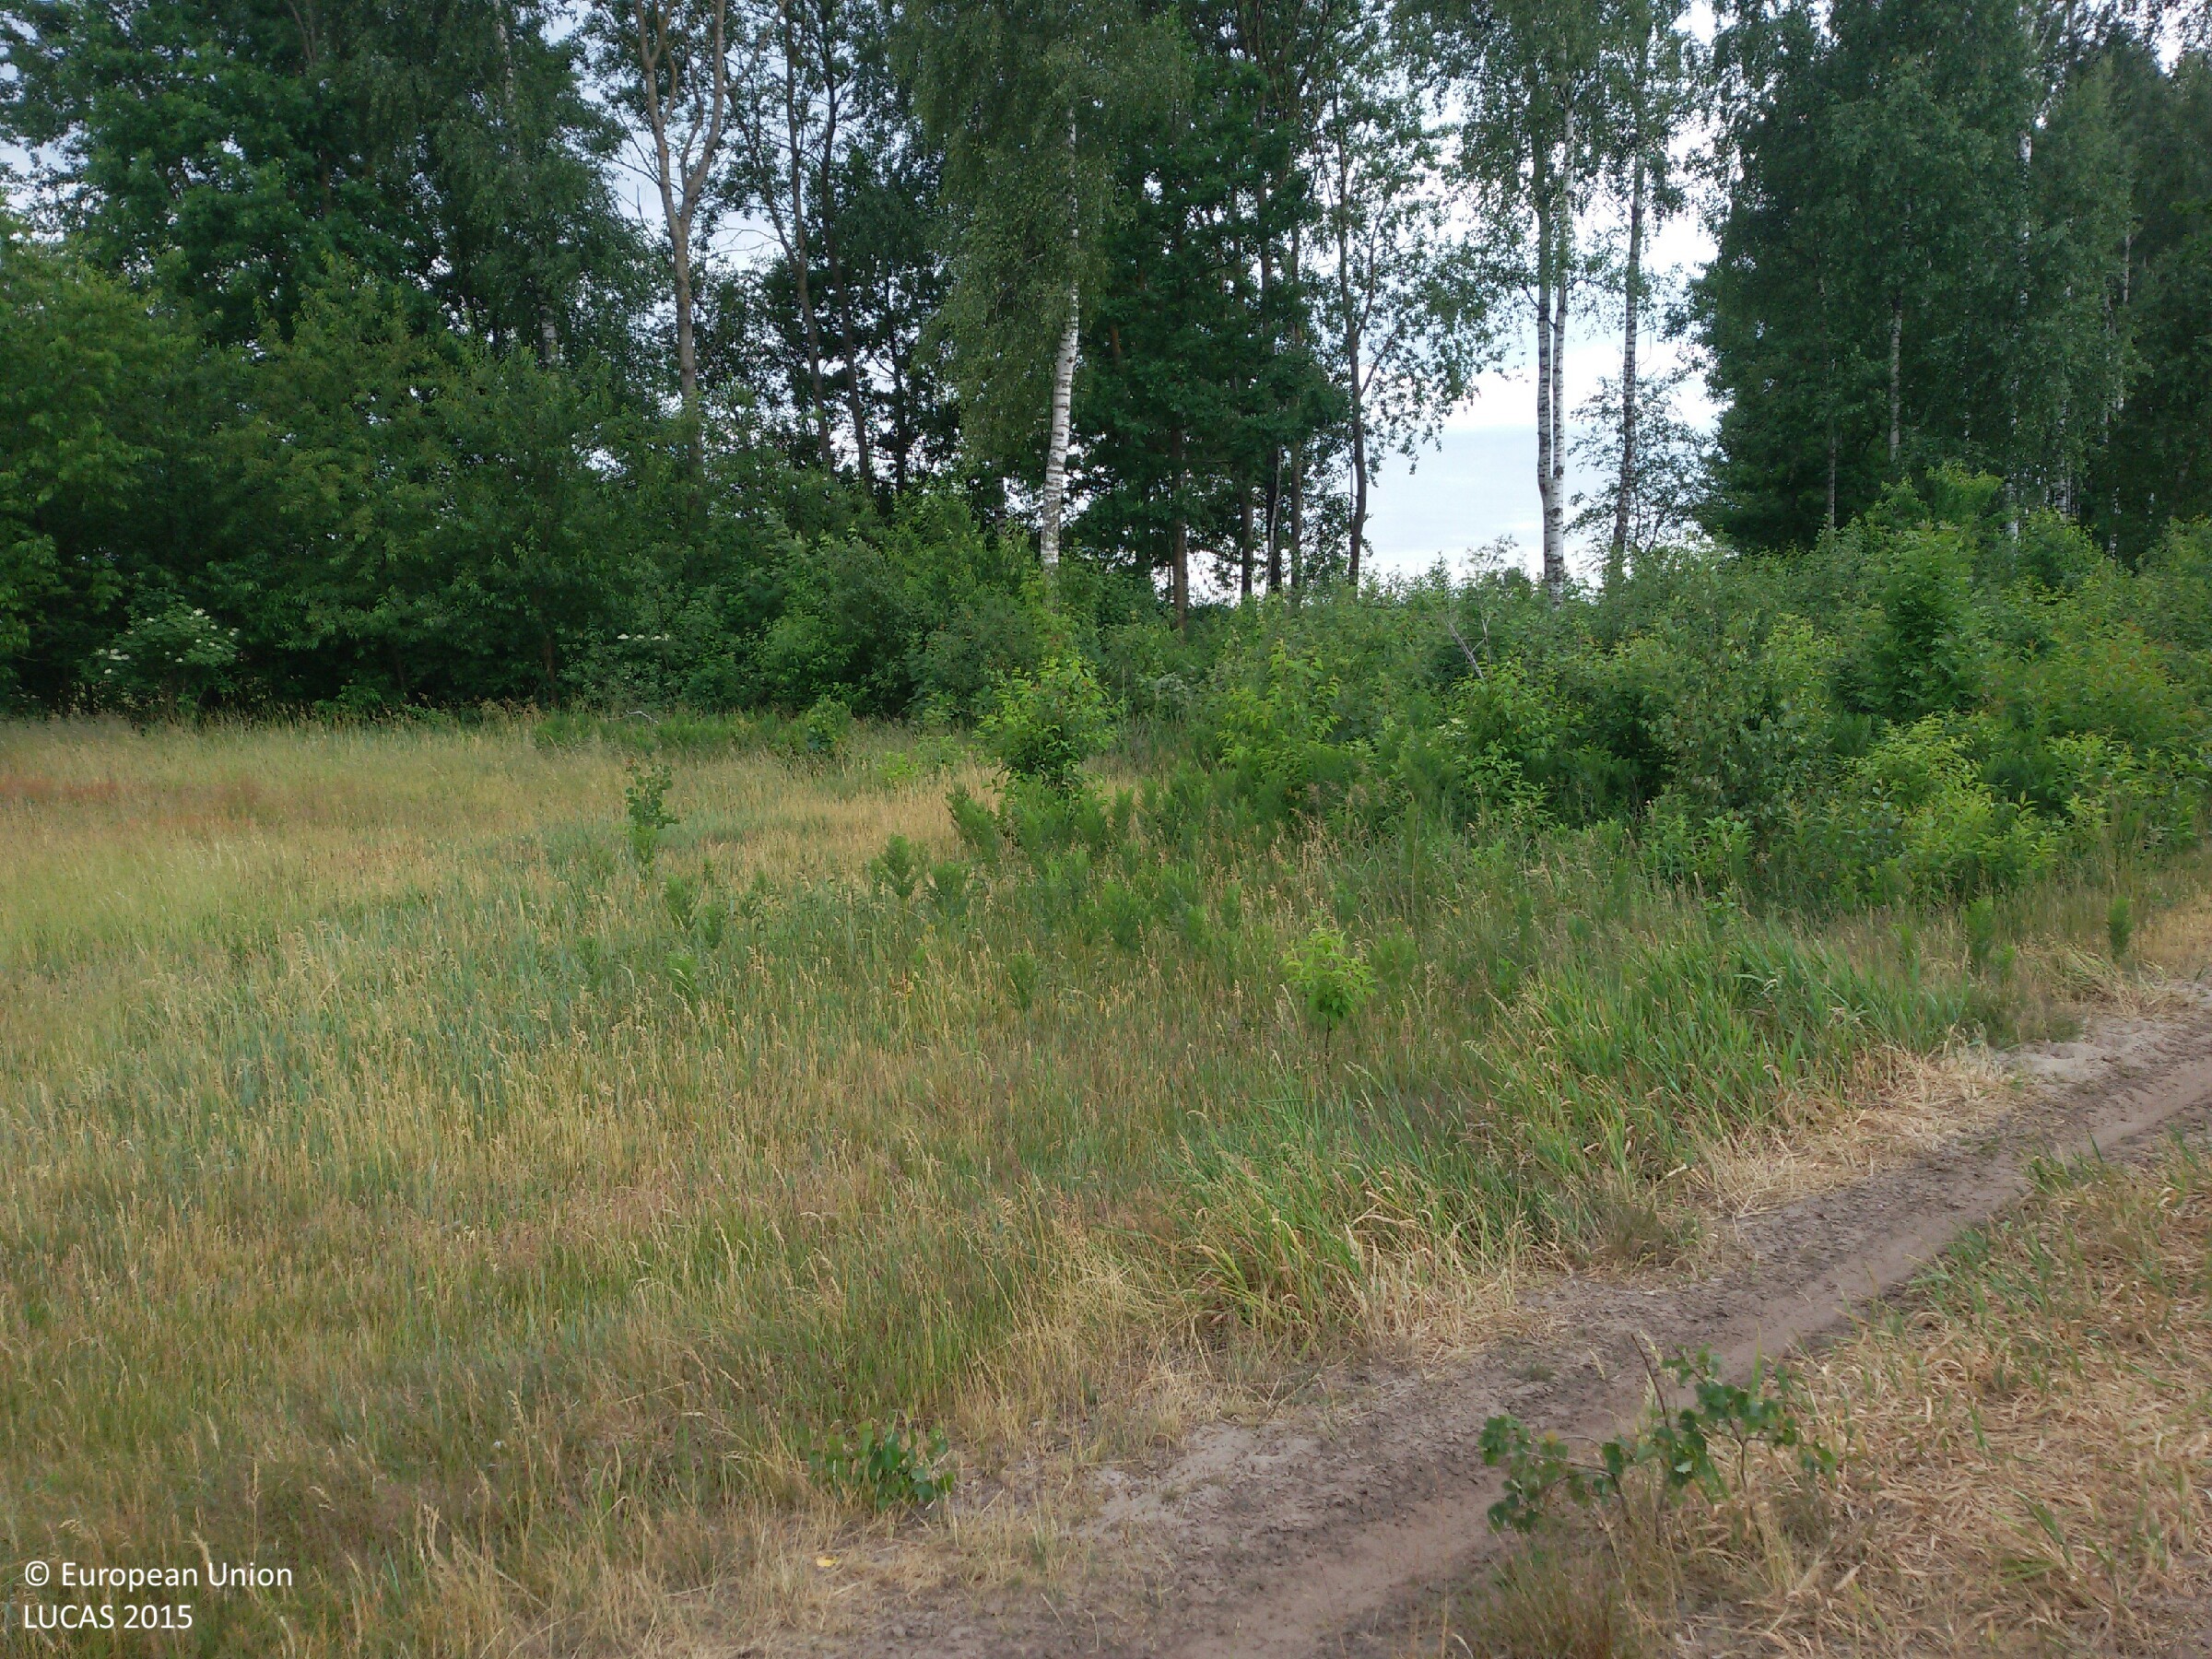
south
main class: Grassland
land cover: Grassland without tree/shrub cover
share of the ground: > 75 %
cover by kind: herbaceous plants 100 %
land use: Agriculture (excluding fallow land and kitchen gardens)
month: June
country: PL
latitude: 53.2824
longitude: 20.9774
